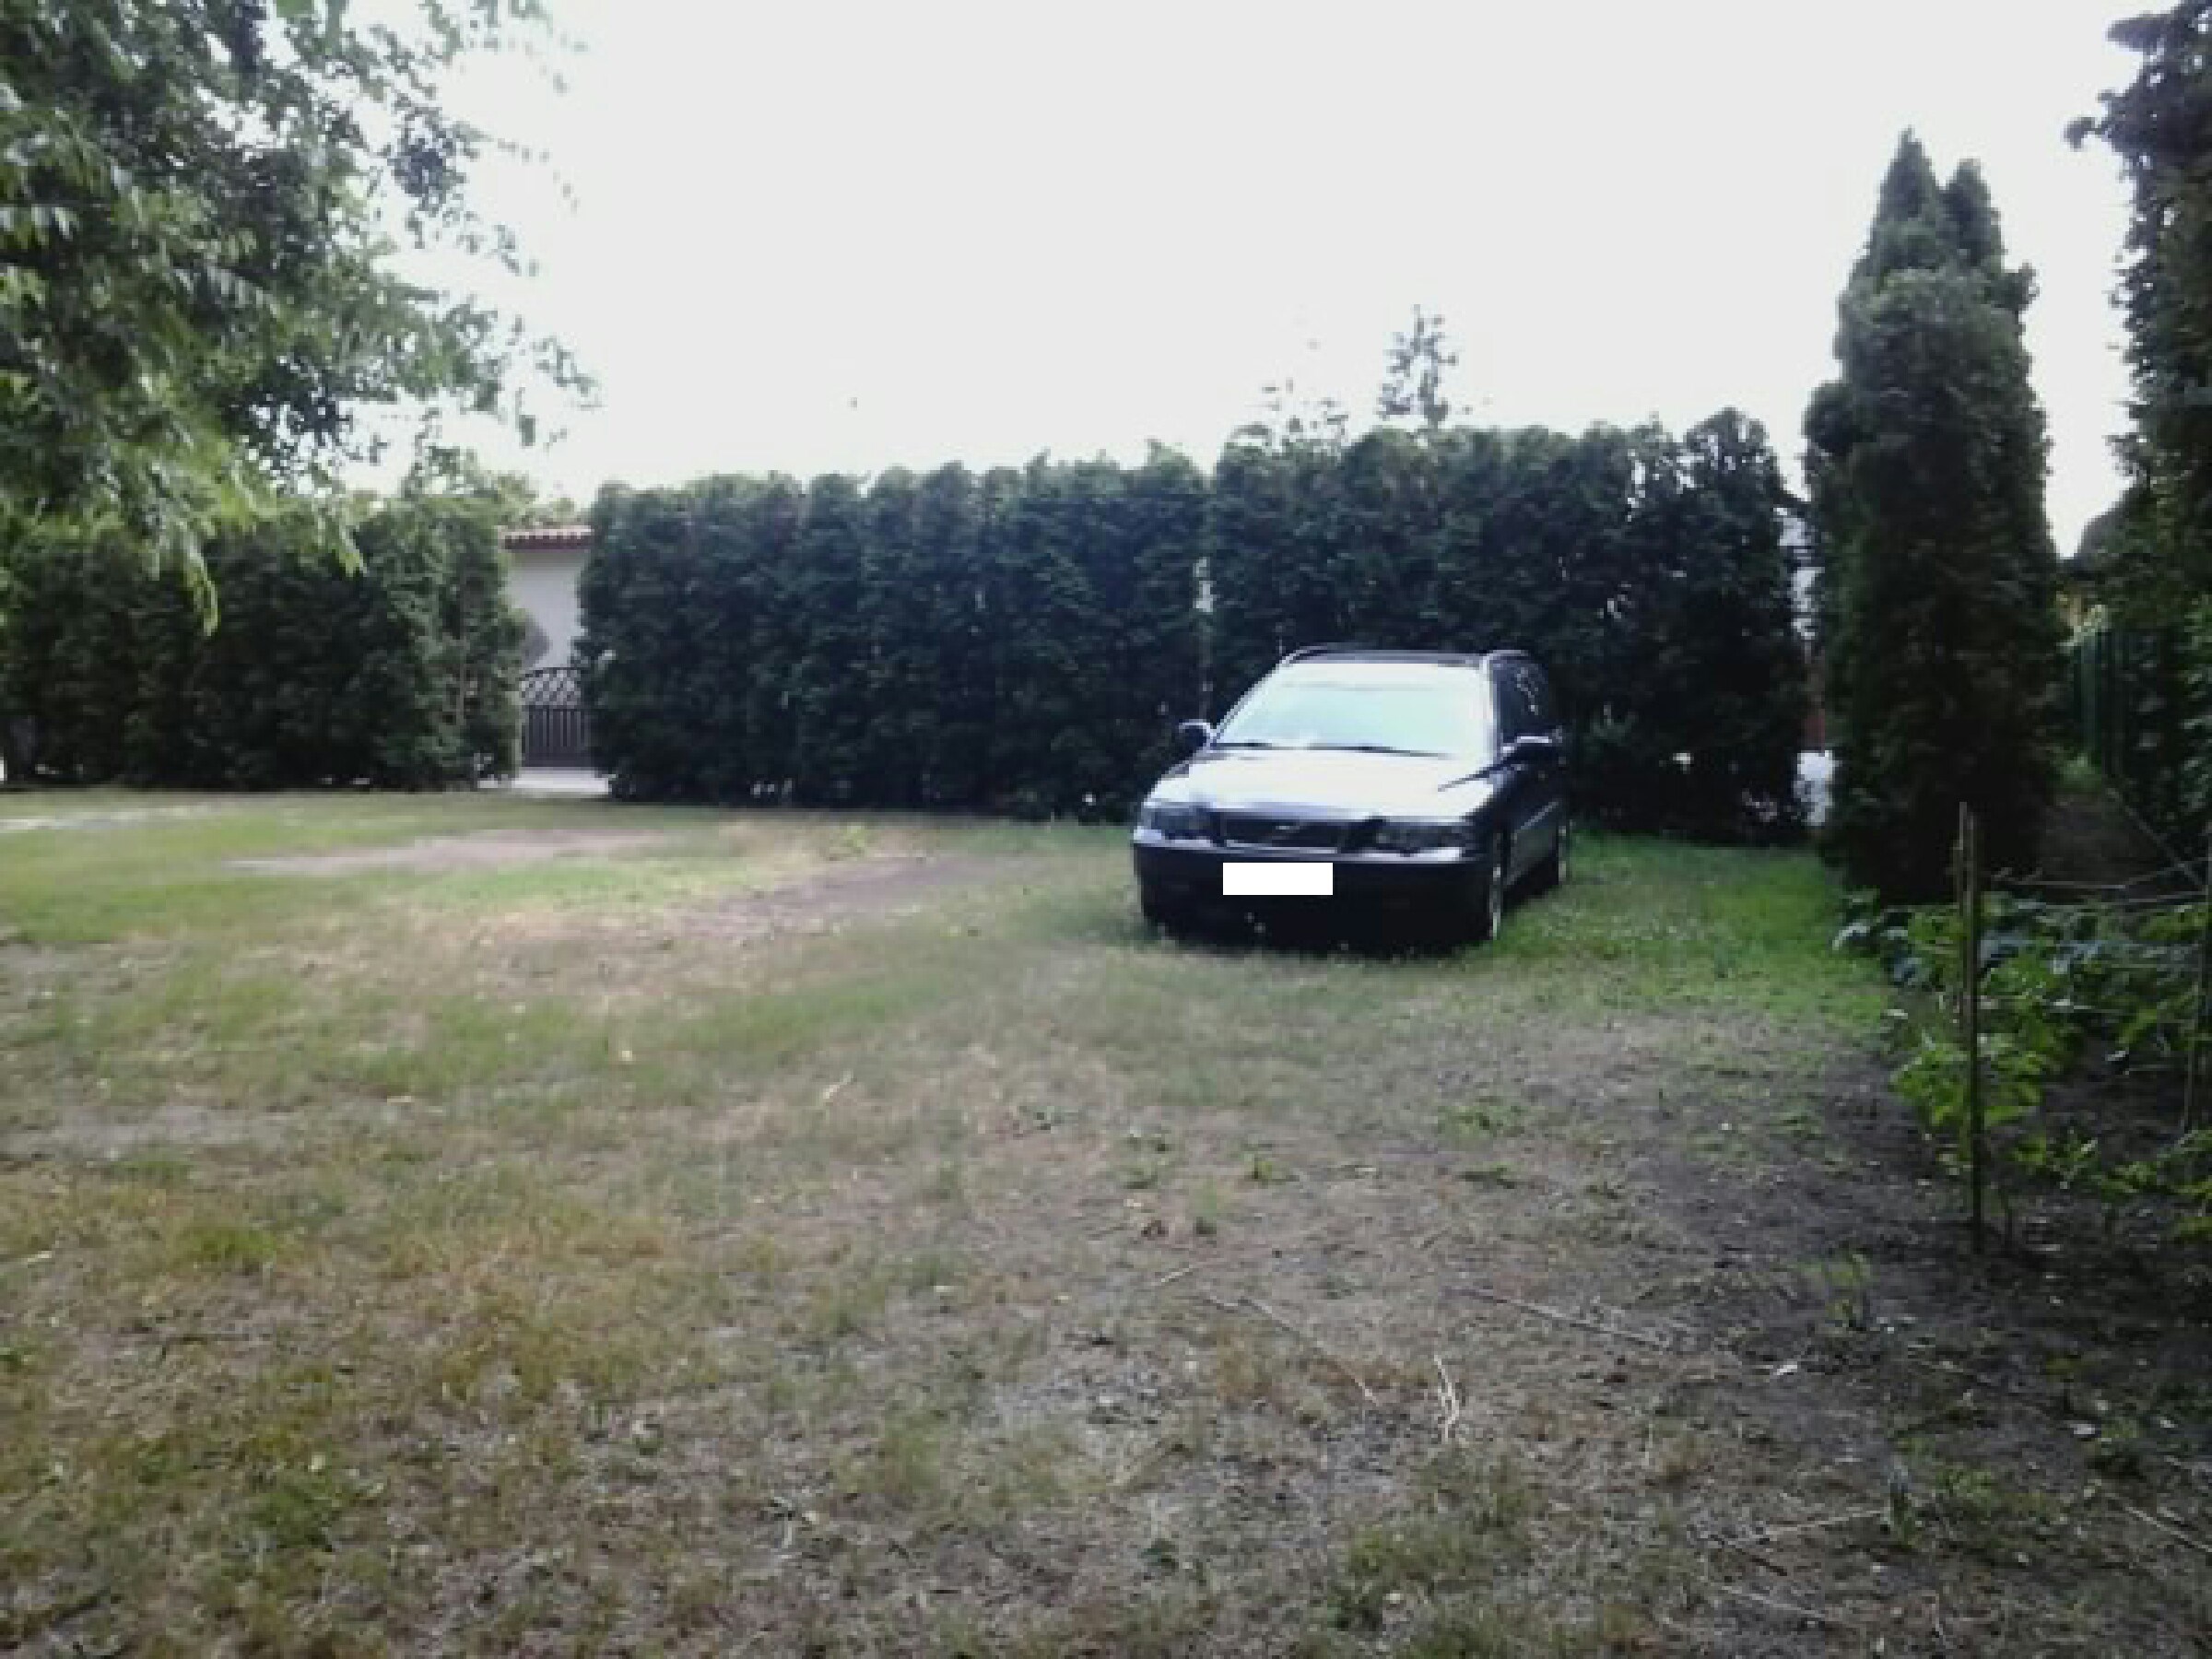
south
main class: Woodland
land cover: Broadleaved woodland
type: mesophytic deciduous forest
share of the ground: > 75 %
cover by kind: broadleaved forest trees 95 %, herbaceous plants 5 %
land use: Amenities, museums, leisure
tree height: > 5 m
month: July
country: HU
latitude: 47.6799
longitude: 19.1438
